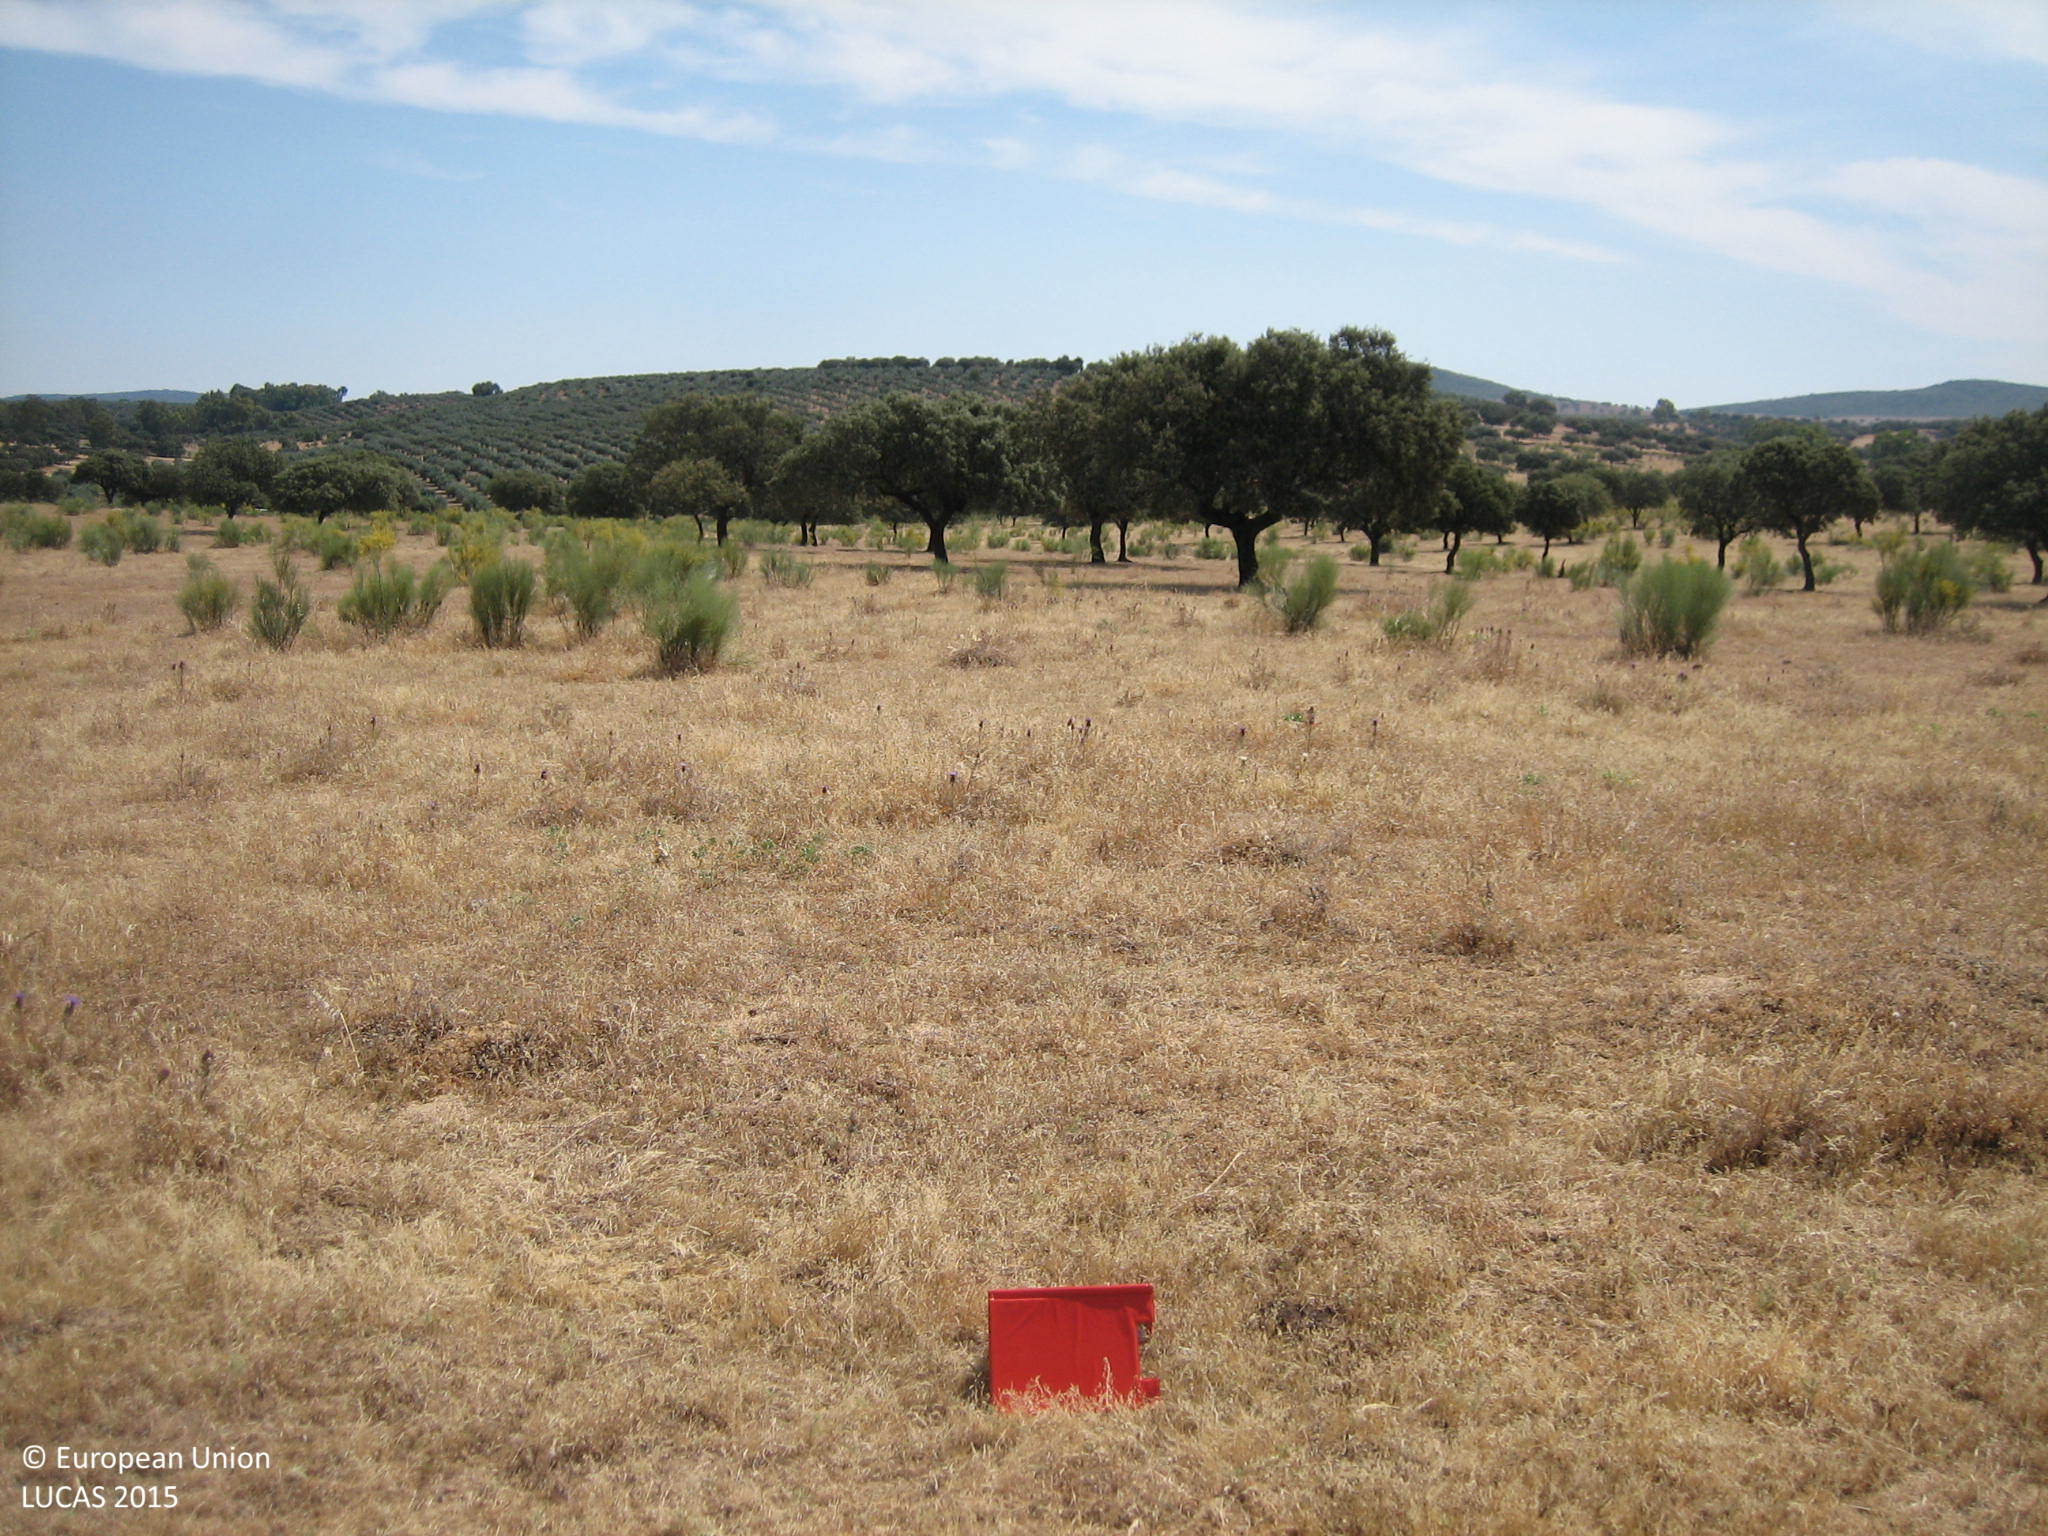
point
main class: Grassland
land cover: Grassland with sparse tree/shrub cover
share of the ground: > 75 %
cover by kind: herbaceous plants 90 %, broadleaved forest trees 5 %, shrubs 5 %
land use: Agriculture (excluding fallow land and kitchen gardens)
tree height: > 5 m
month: June
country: ES
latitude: 38.9877
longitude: -4.8215
